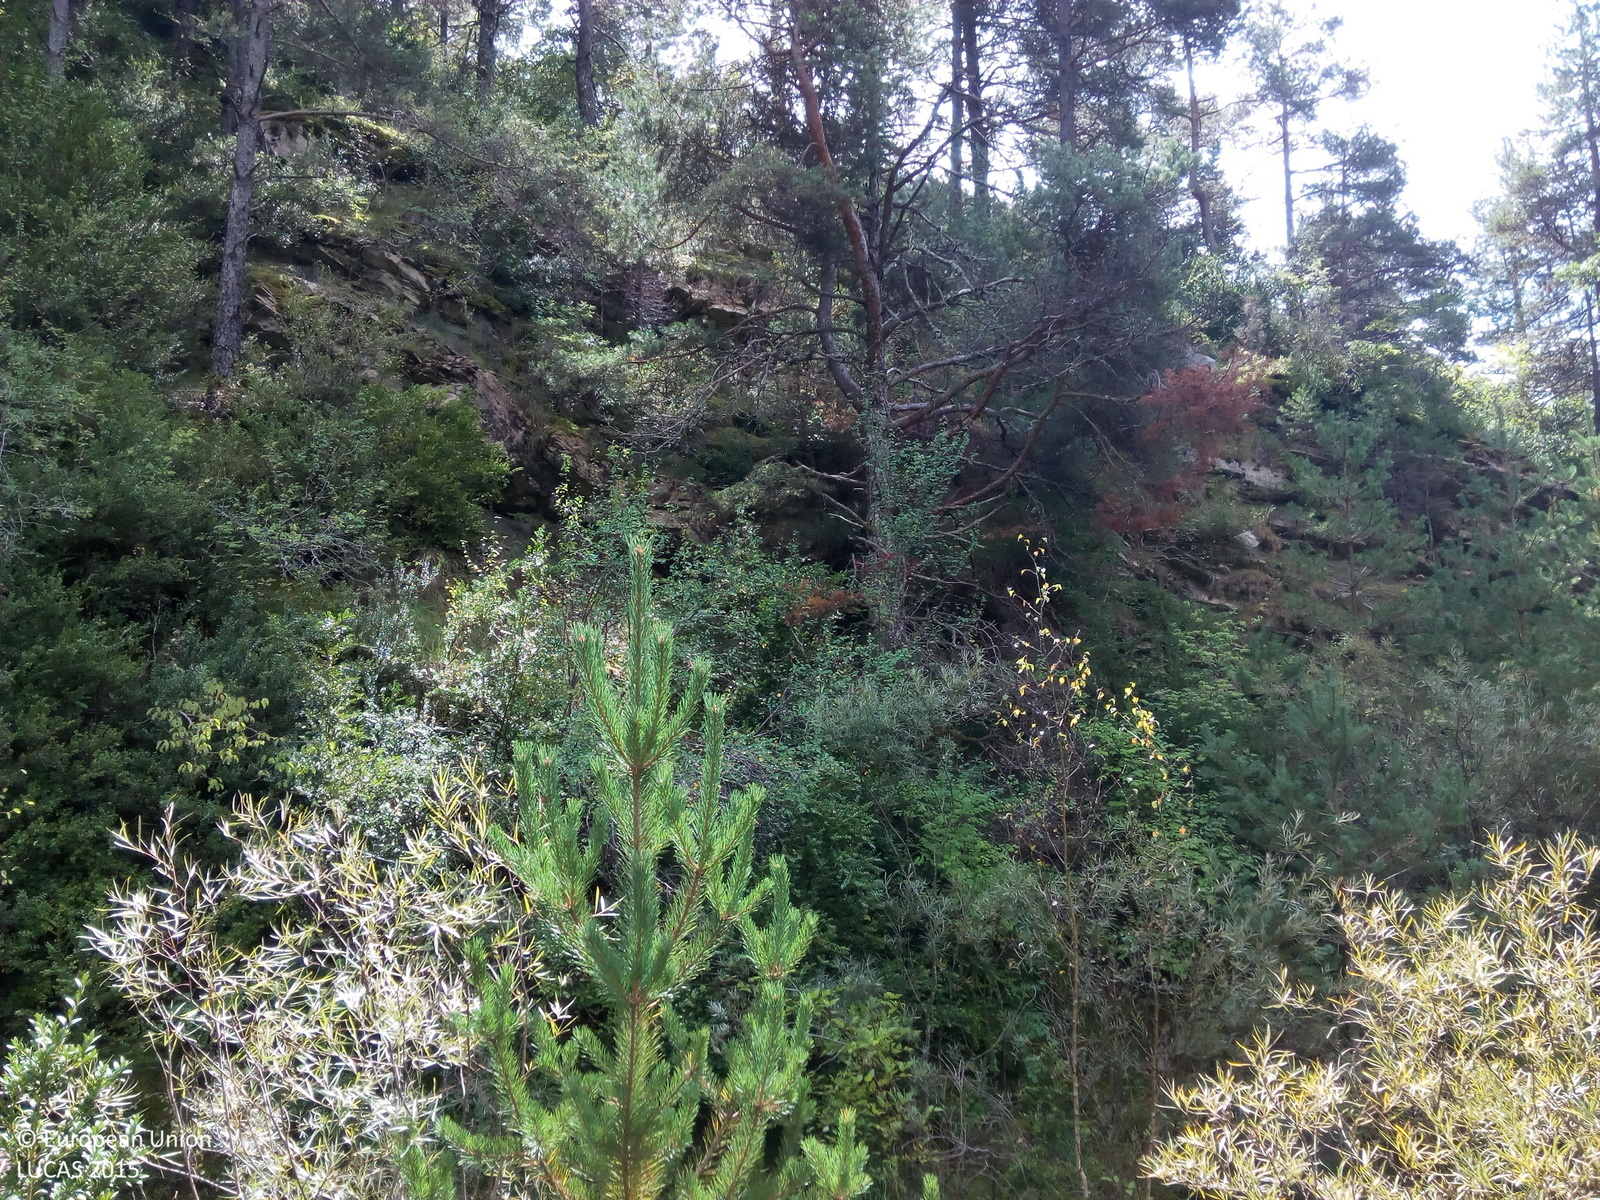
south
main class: Woodland
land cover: Pine dominated coniferous woodland
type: coniferous forest of the mediterranean region
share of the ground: > 75 %
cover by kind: coniferous forest trees 75 %, shrubs 25 %
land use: Semi-natural and natural areas not in use
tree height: > 5 m
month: September
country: ES
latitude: 42.4415
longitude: 0.4859
